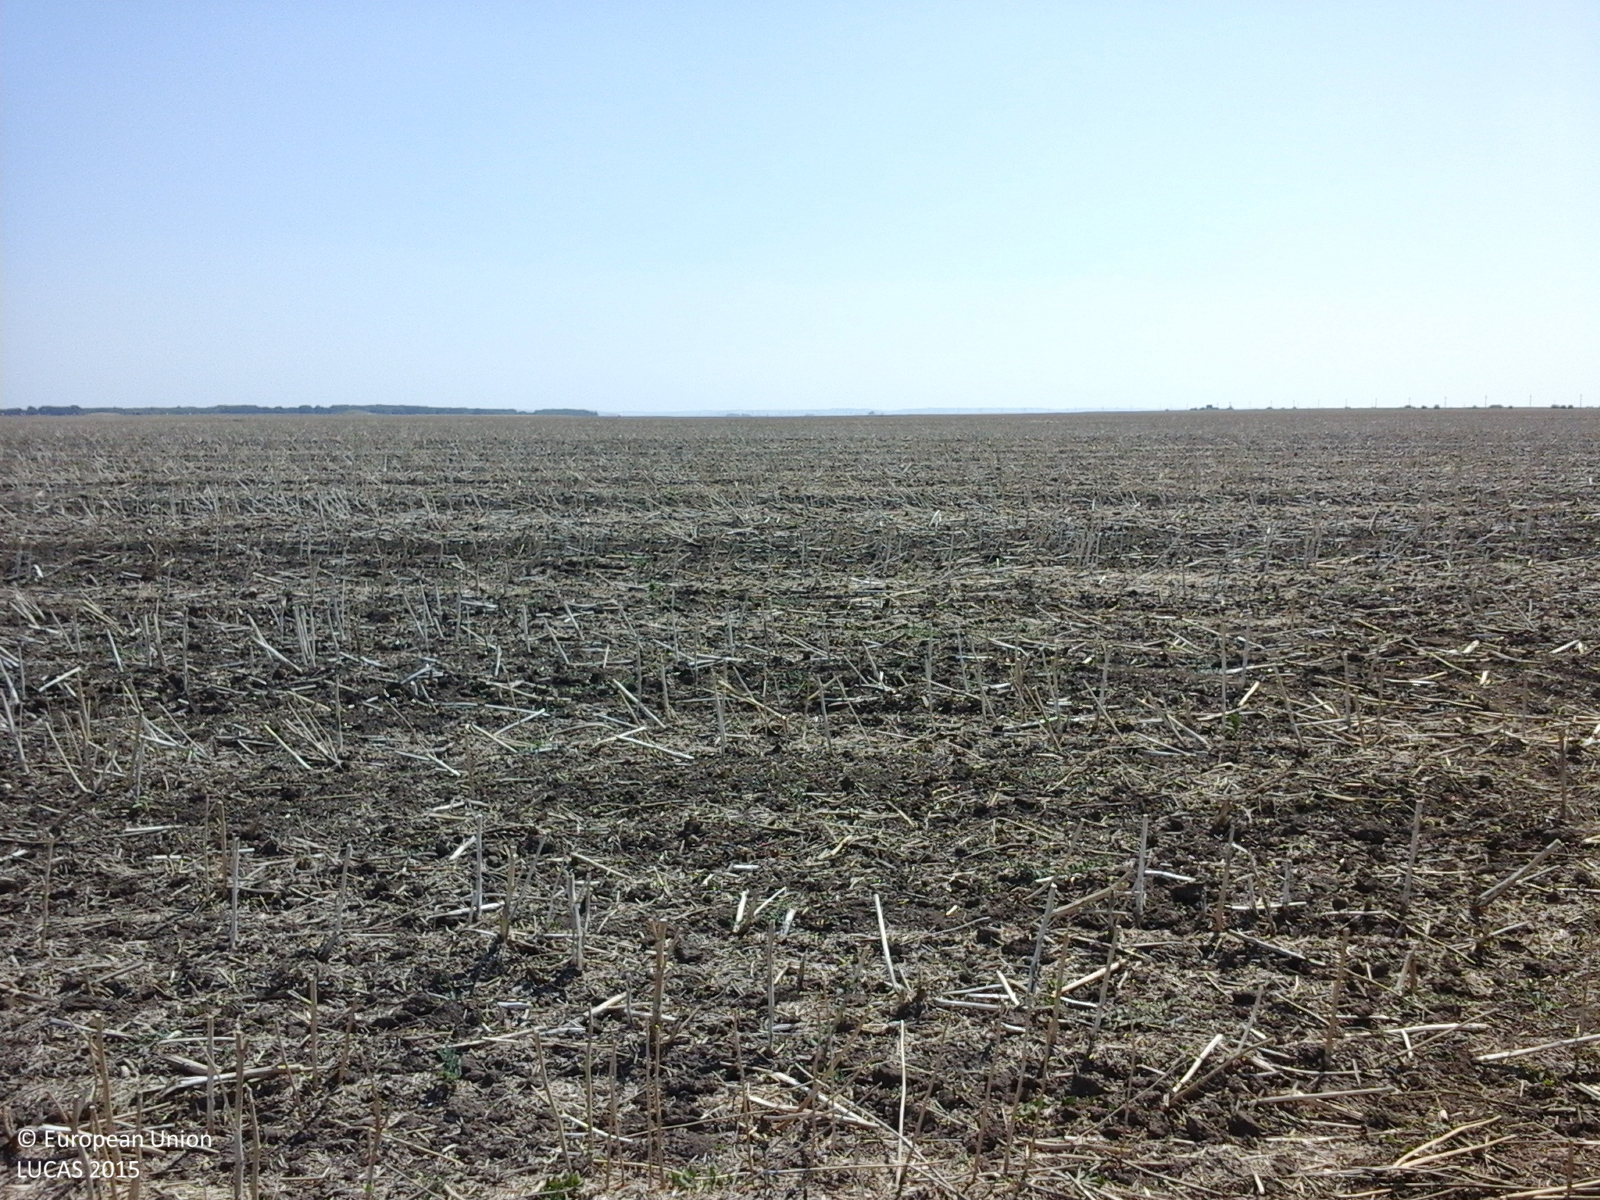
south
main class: Cropland
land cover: Rape and turnip rape
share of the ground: < 10 %
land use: Agriculture (excluding fallow land and kitchen gardens)
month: July
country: RO
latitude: 44.2860
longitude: 26.9547
